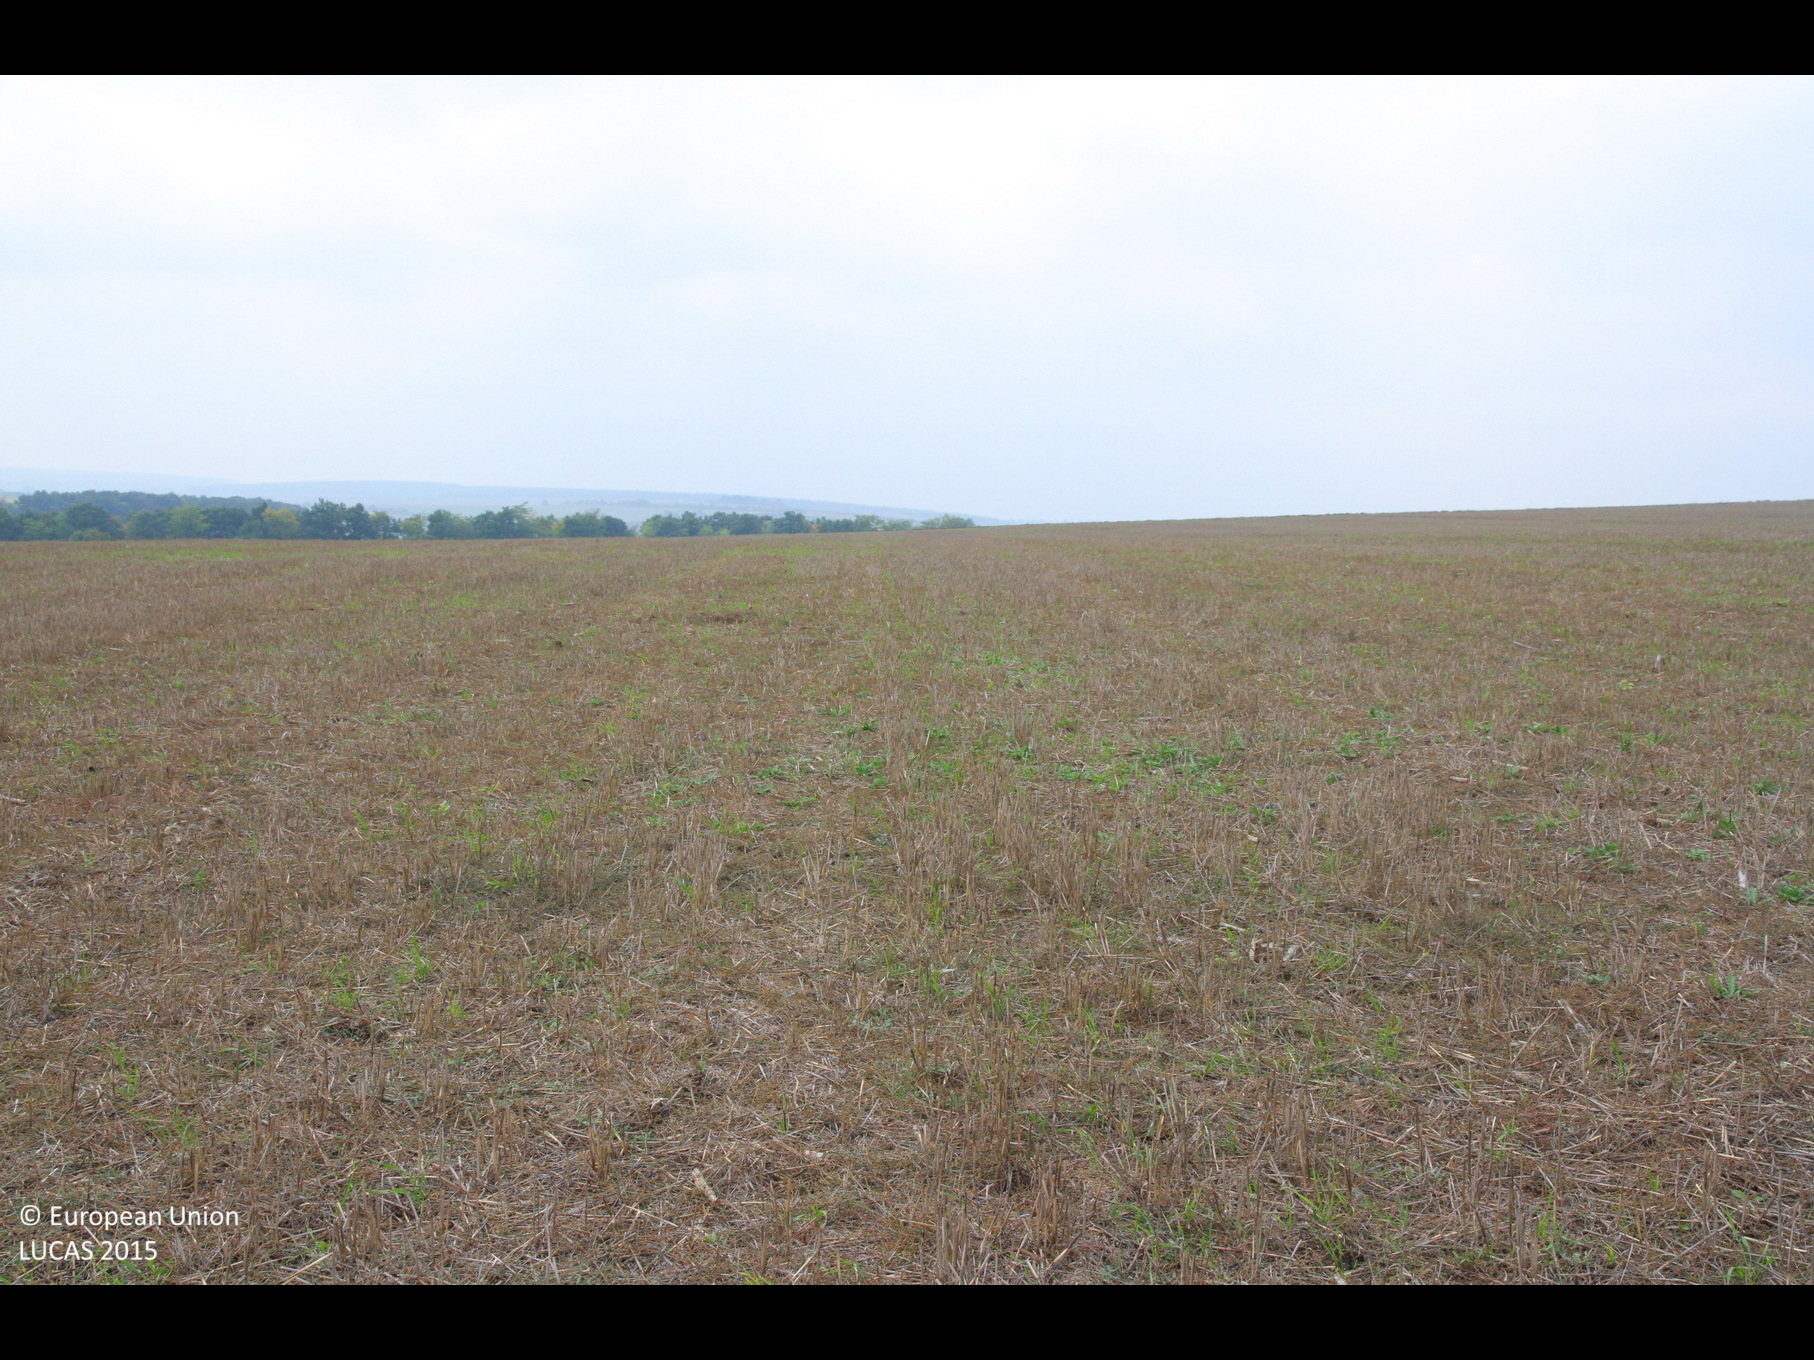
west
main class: Cropland
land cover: Common wheat
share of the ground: < 10 %
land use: Agriculture (excluding fallow land and kitchen gardens)
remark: Harvested field
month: October
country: BG
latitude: 43.5757
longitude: 27.0216
